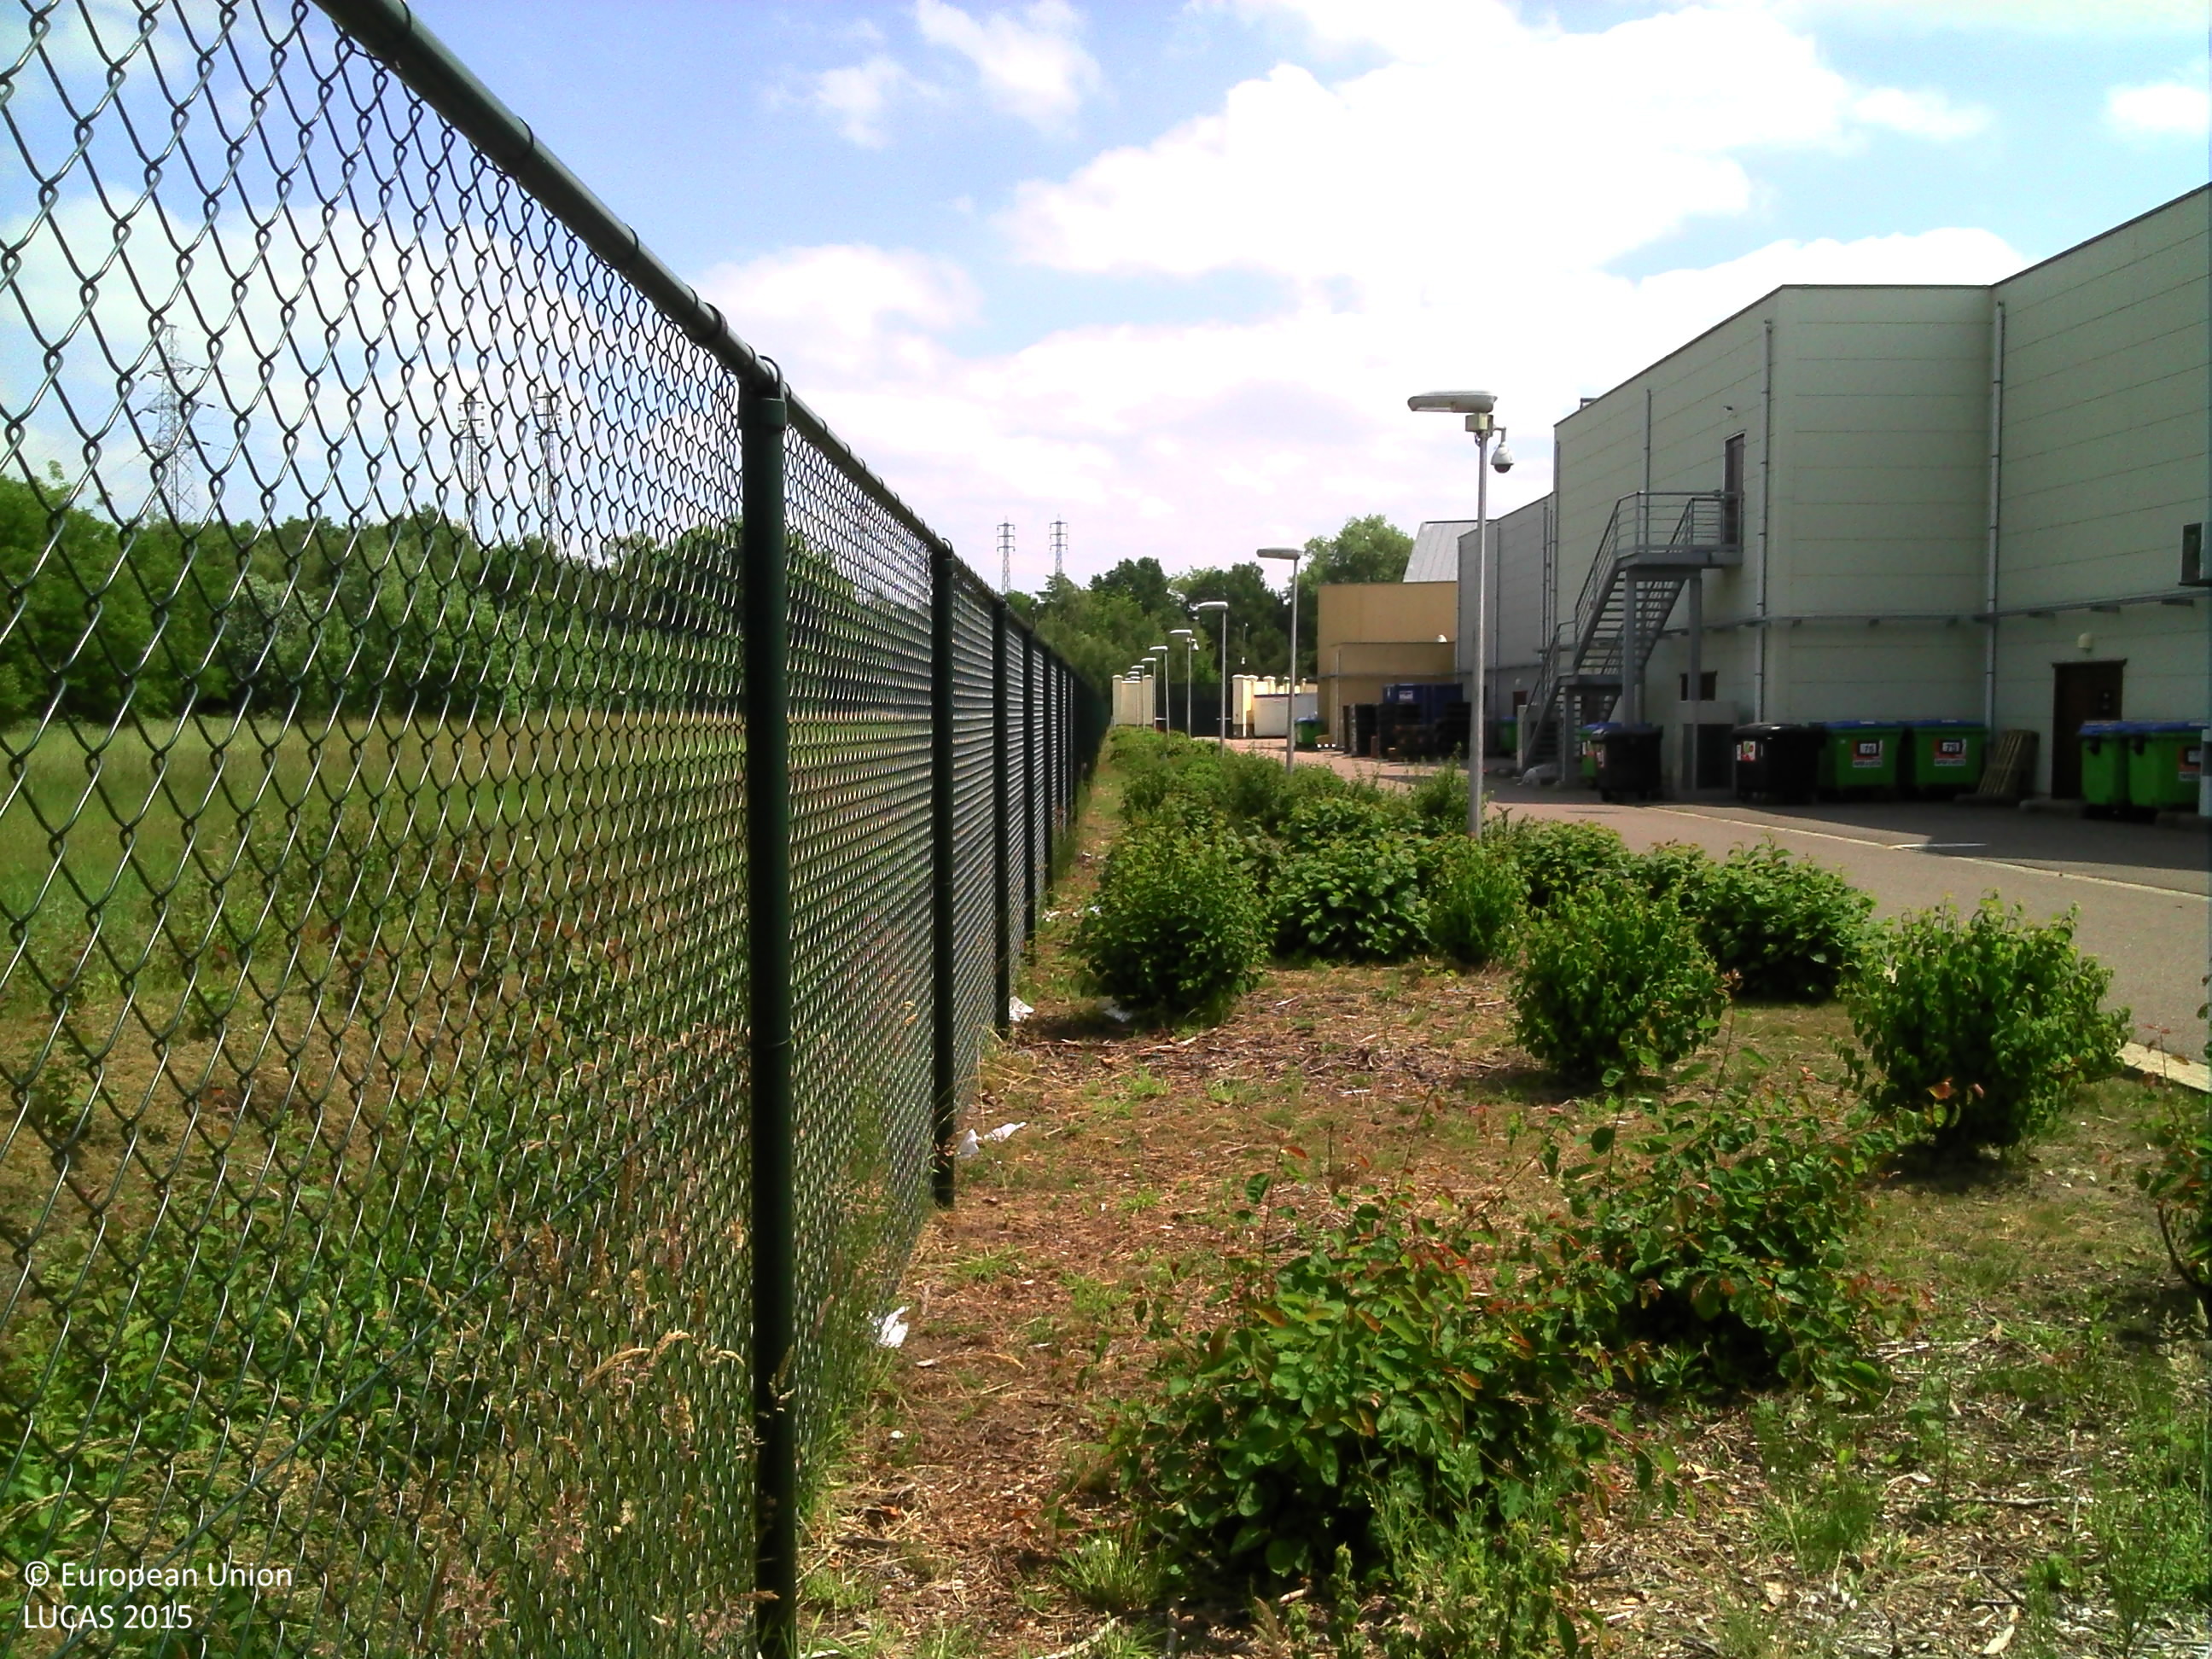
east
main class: Grassland
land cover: Grassland with sparse tree/shrub cover
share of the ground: > 75 %
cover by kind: herbaceous plants 95 %, broadleaved forest trees 5 %
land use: Semi-natural and natural areas not in use
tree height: < 5 m
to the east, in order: Grassland with sparse tree/shrub cover; Fences; Shrubland without tree cover; Artificial constructions in urban areas; Grassland with sparse tree/shrub cover; Tracks; Grass margins; Inland fresh running water
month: June
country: BE
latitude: 51.0038
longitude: 5.7090
